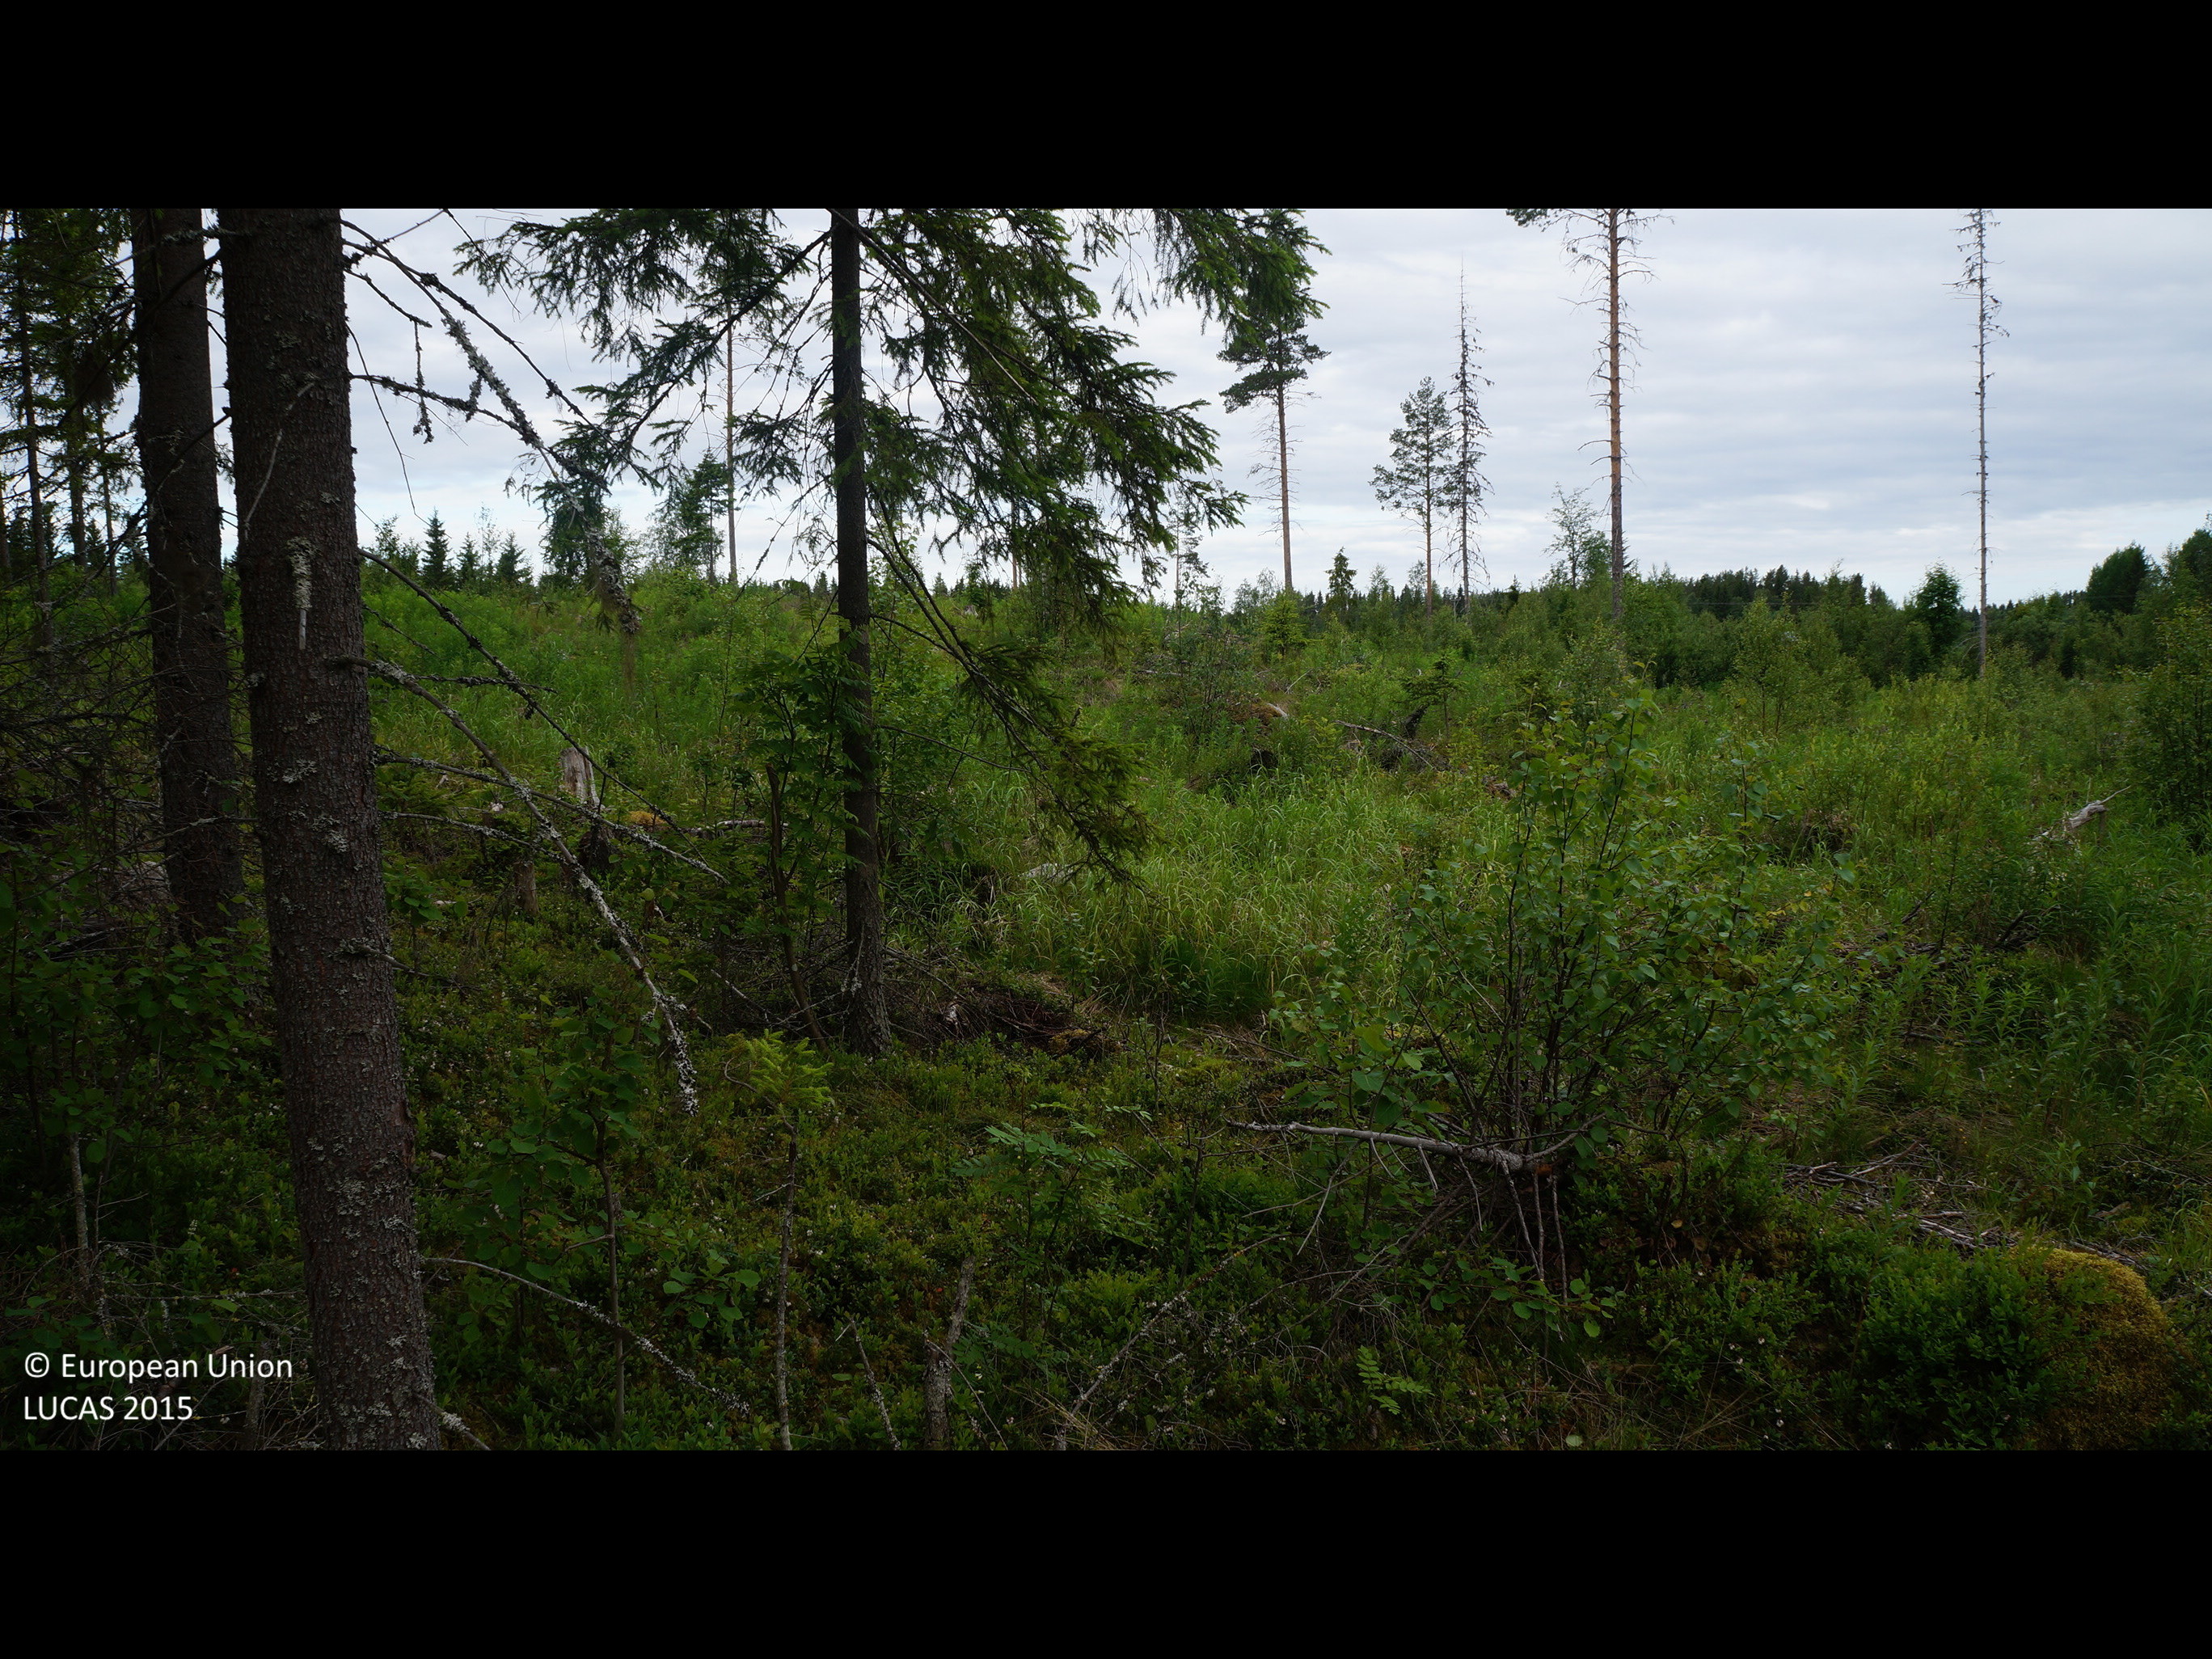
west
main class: Woodland
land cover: Other coniferous woodland
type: boreal forest
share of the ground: 25 - 50 %
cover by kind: shrubs 55 %, coniferous forest trees 35 %, herbaceous plants 5 %, lichens and mosses 5 %
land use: Forestry
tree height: > 5 m
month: July
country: FI
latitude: 64.2796
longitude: 24.5077
